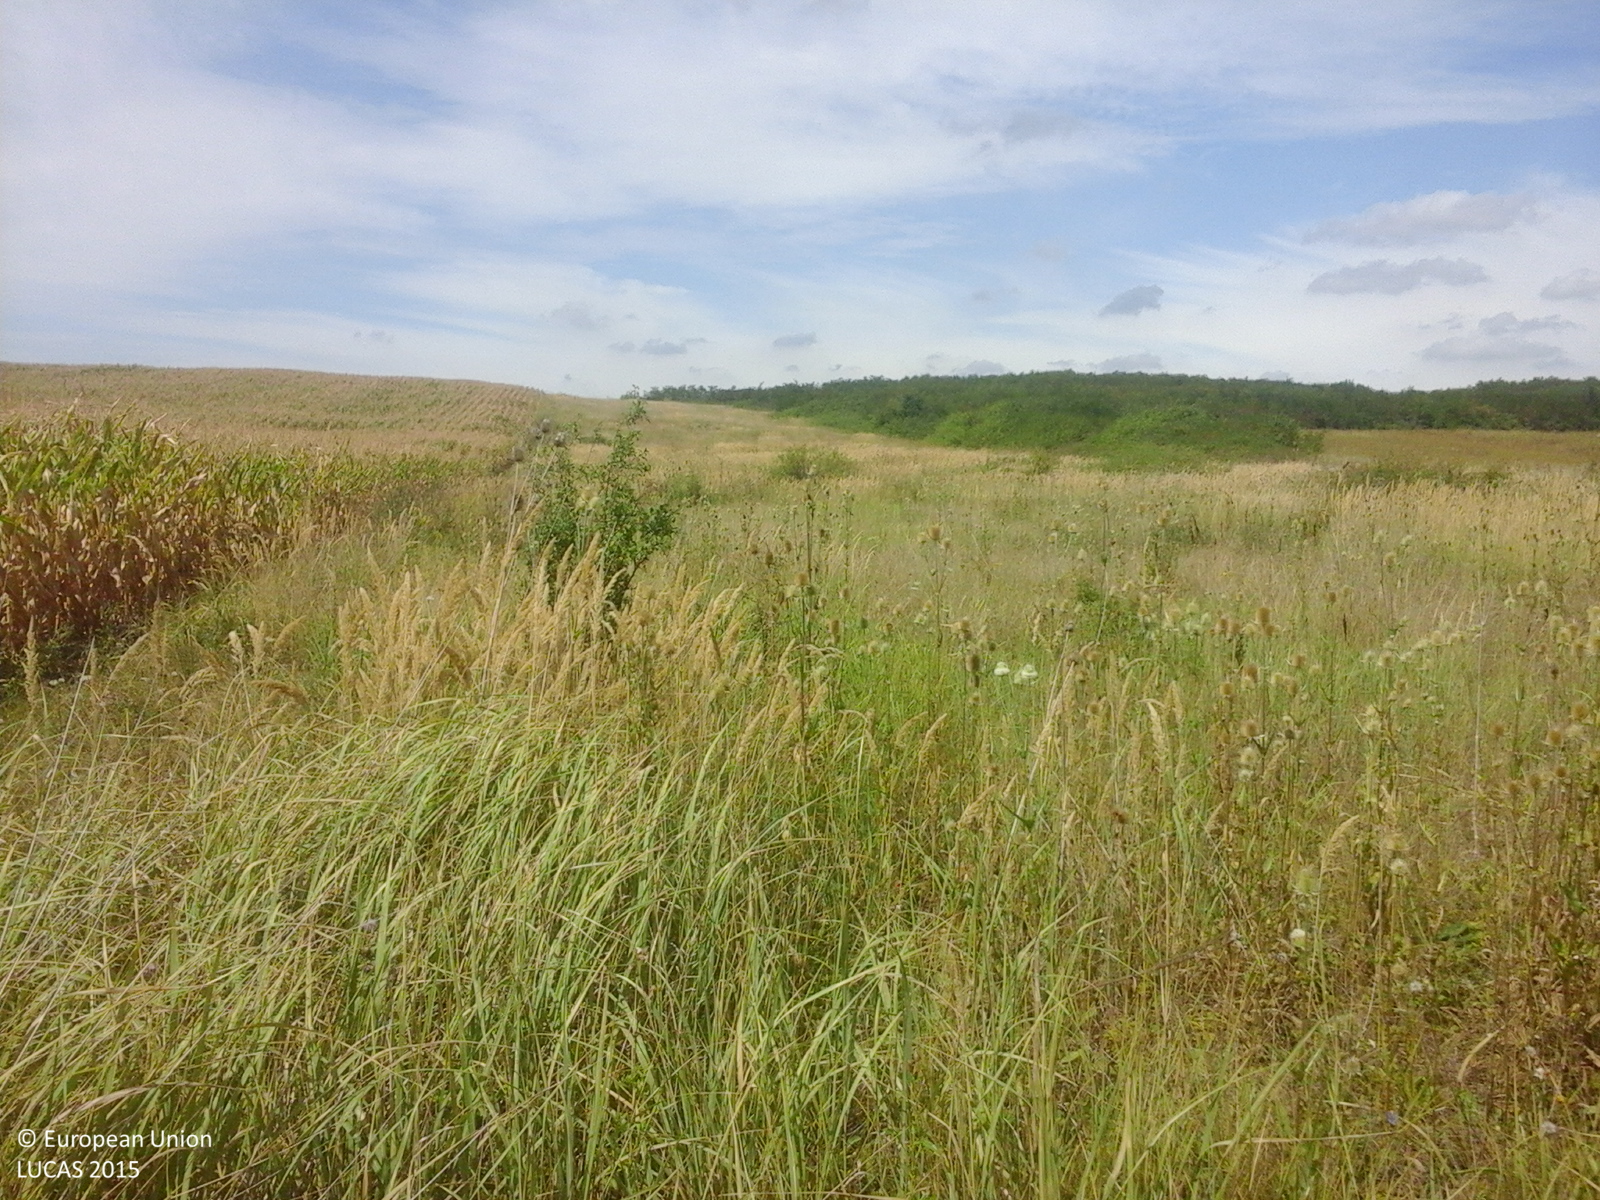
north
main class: Grassland
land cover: Grassland with sparse tree/shrub cover
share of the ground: > 75 %
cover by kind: herbaceous plants 85 %, shrubs 10 %, broadleaved forest trees 5 %
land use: Fallow land
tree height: < 5 m
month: August
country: RO
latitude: 45.3572
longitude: 21.4043
